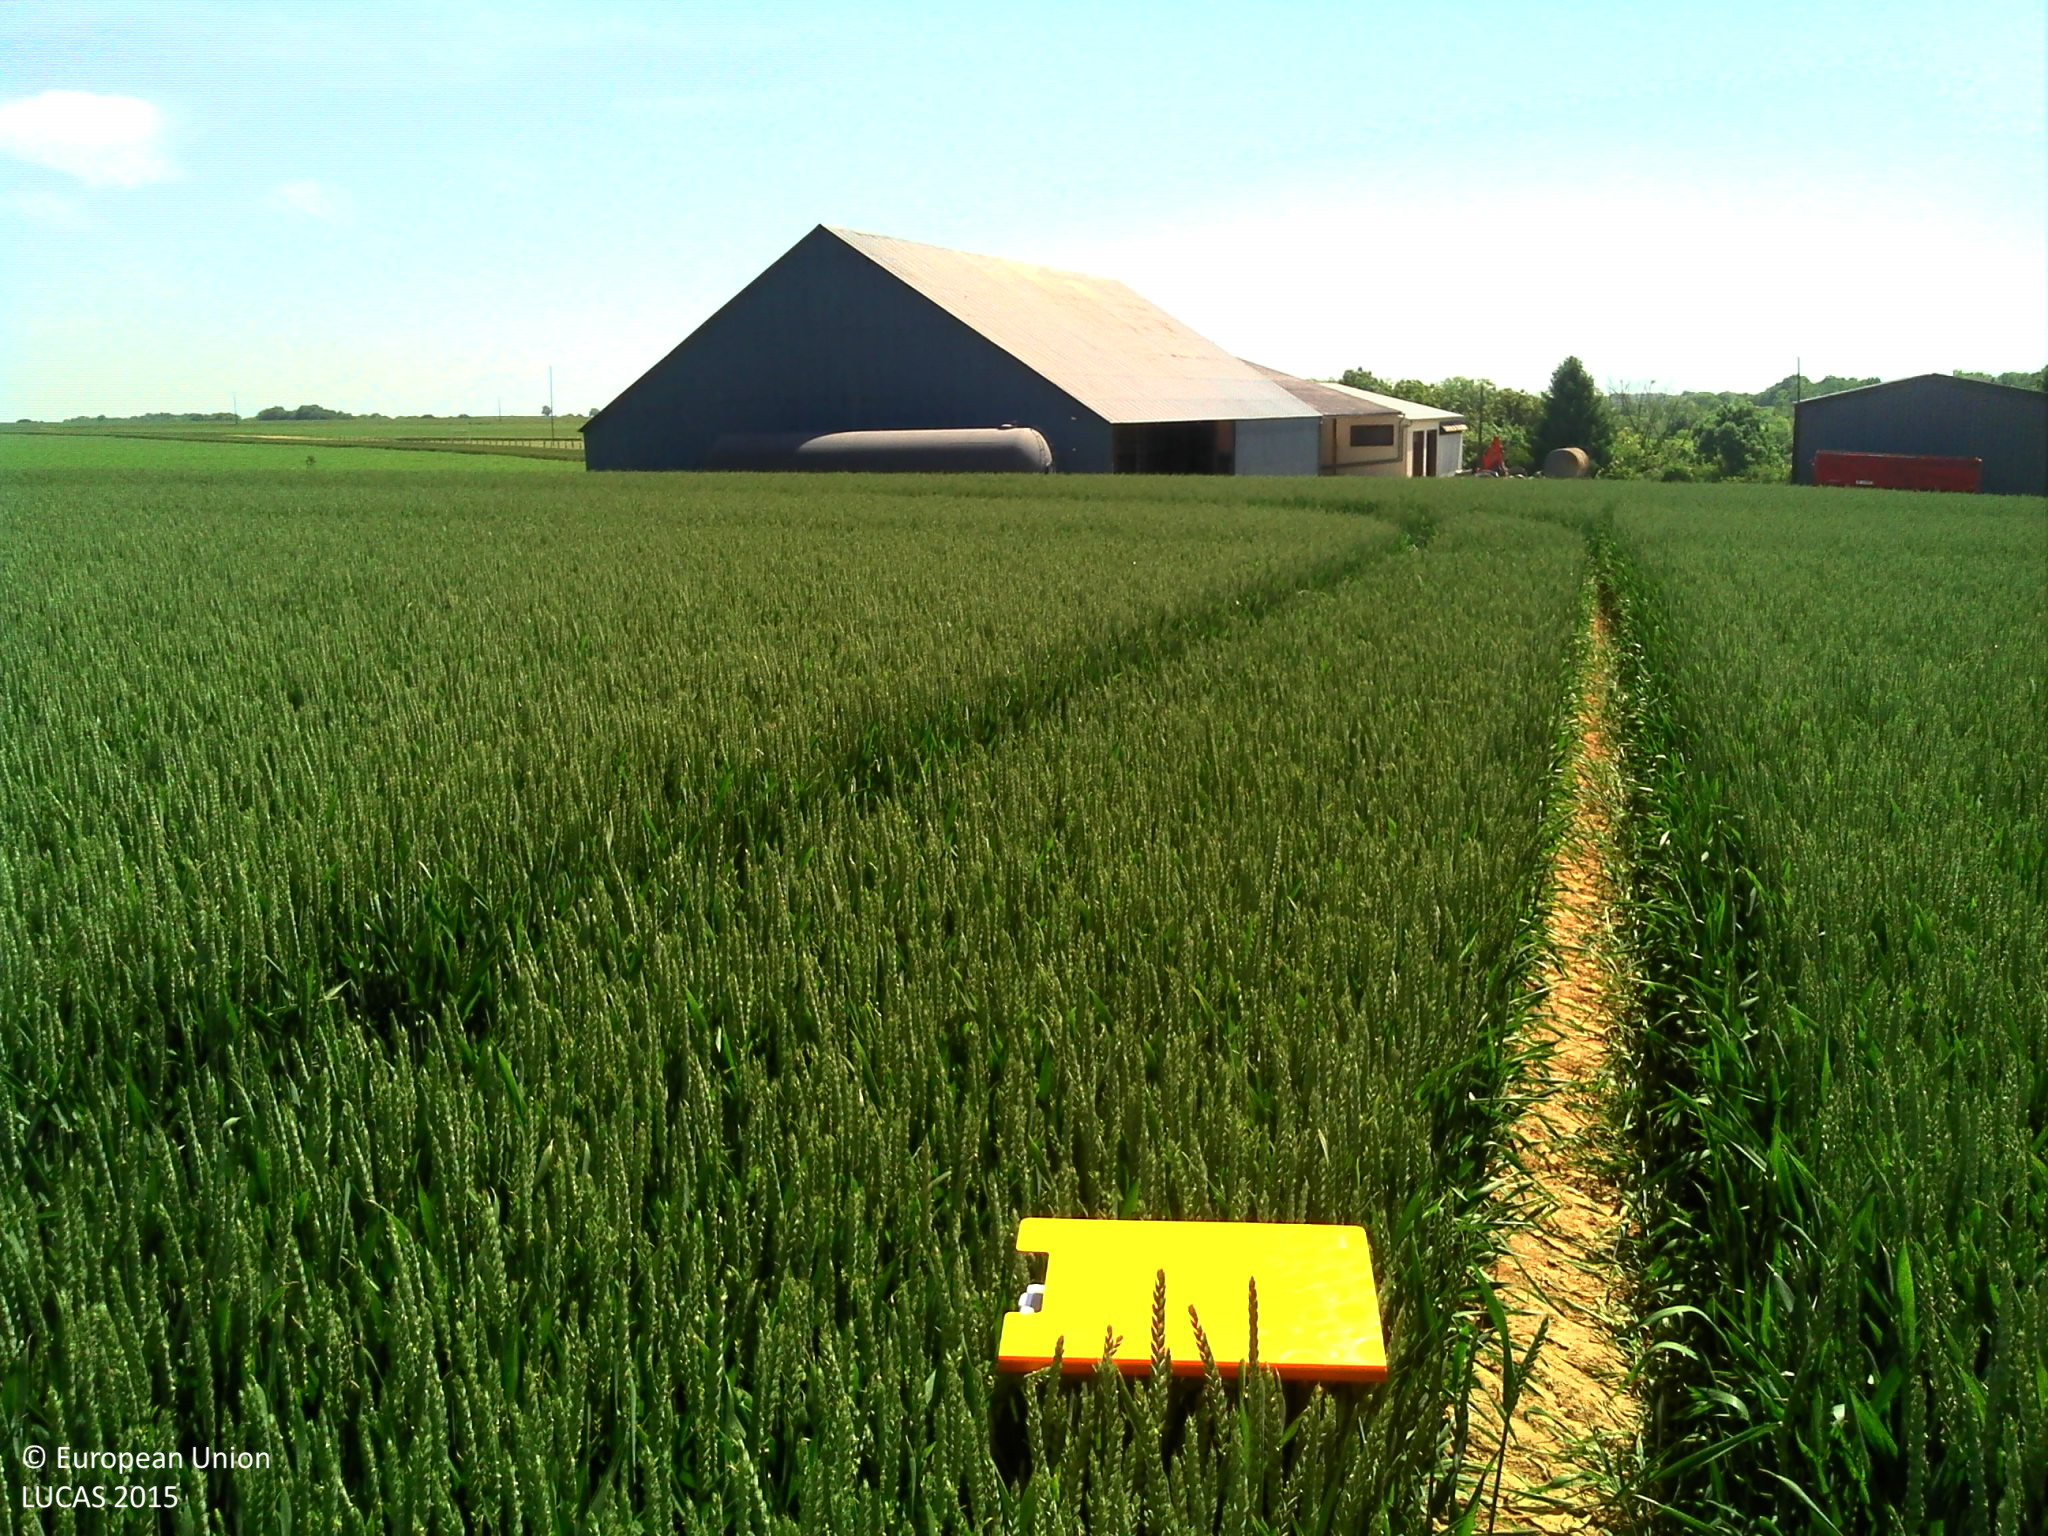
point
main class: Cropland
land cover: Common wheat
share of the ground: > 75 %
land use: Agriculture (excluding fallow land and kitchen gardens)
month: June
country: FR
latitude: 49.4247
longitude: 3.2501
